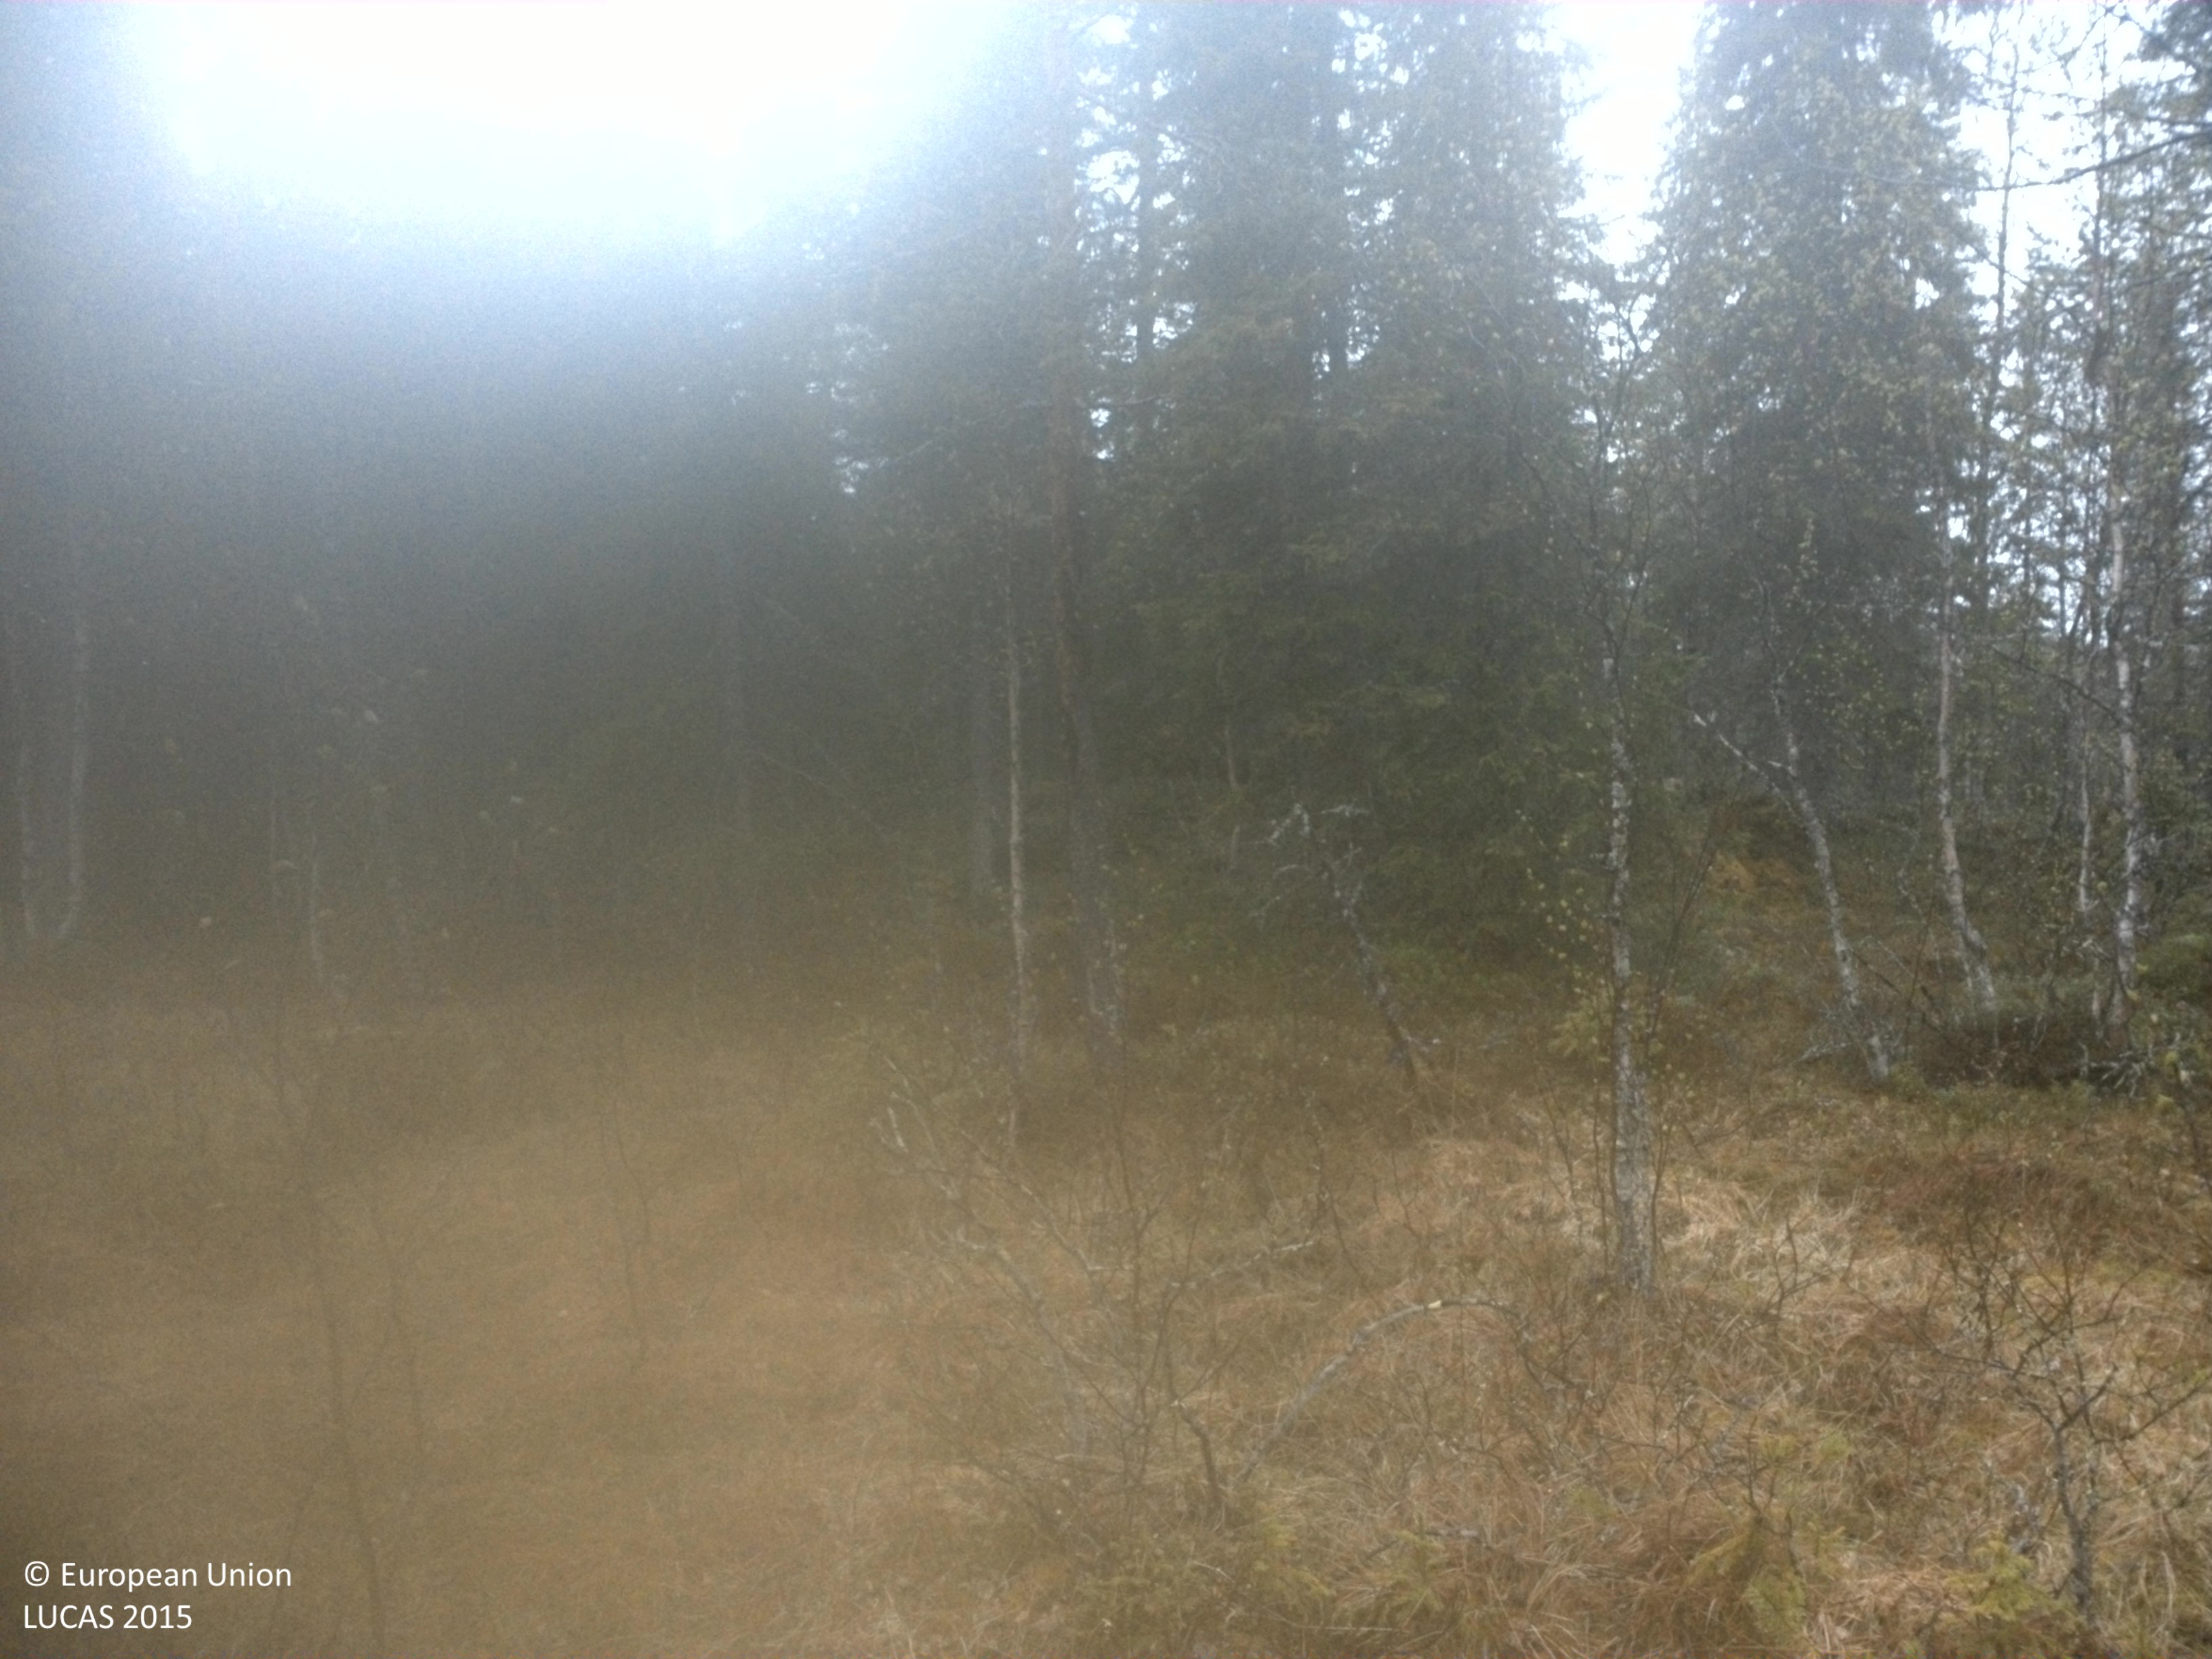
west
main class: Woodland
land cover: Spruce dominated mixed woodland
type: boreal forest
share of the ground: 25 - 50 %
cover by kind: lichens and mosses 35 %, coniferous forest trees 30 %, herbaceous plants 20 %, broadleaved forest trees 10 %, shrubs 5 %
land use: Forestry
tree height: > 5 m
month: June
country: SE
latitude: 64.3185
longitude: 18.0968
